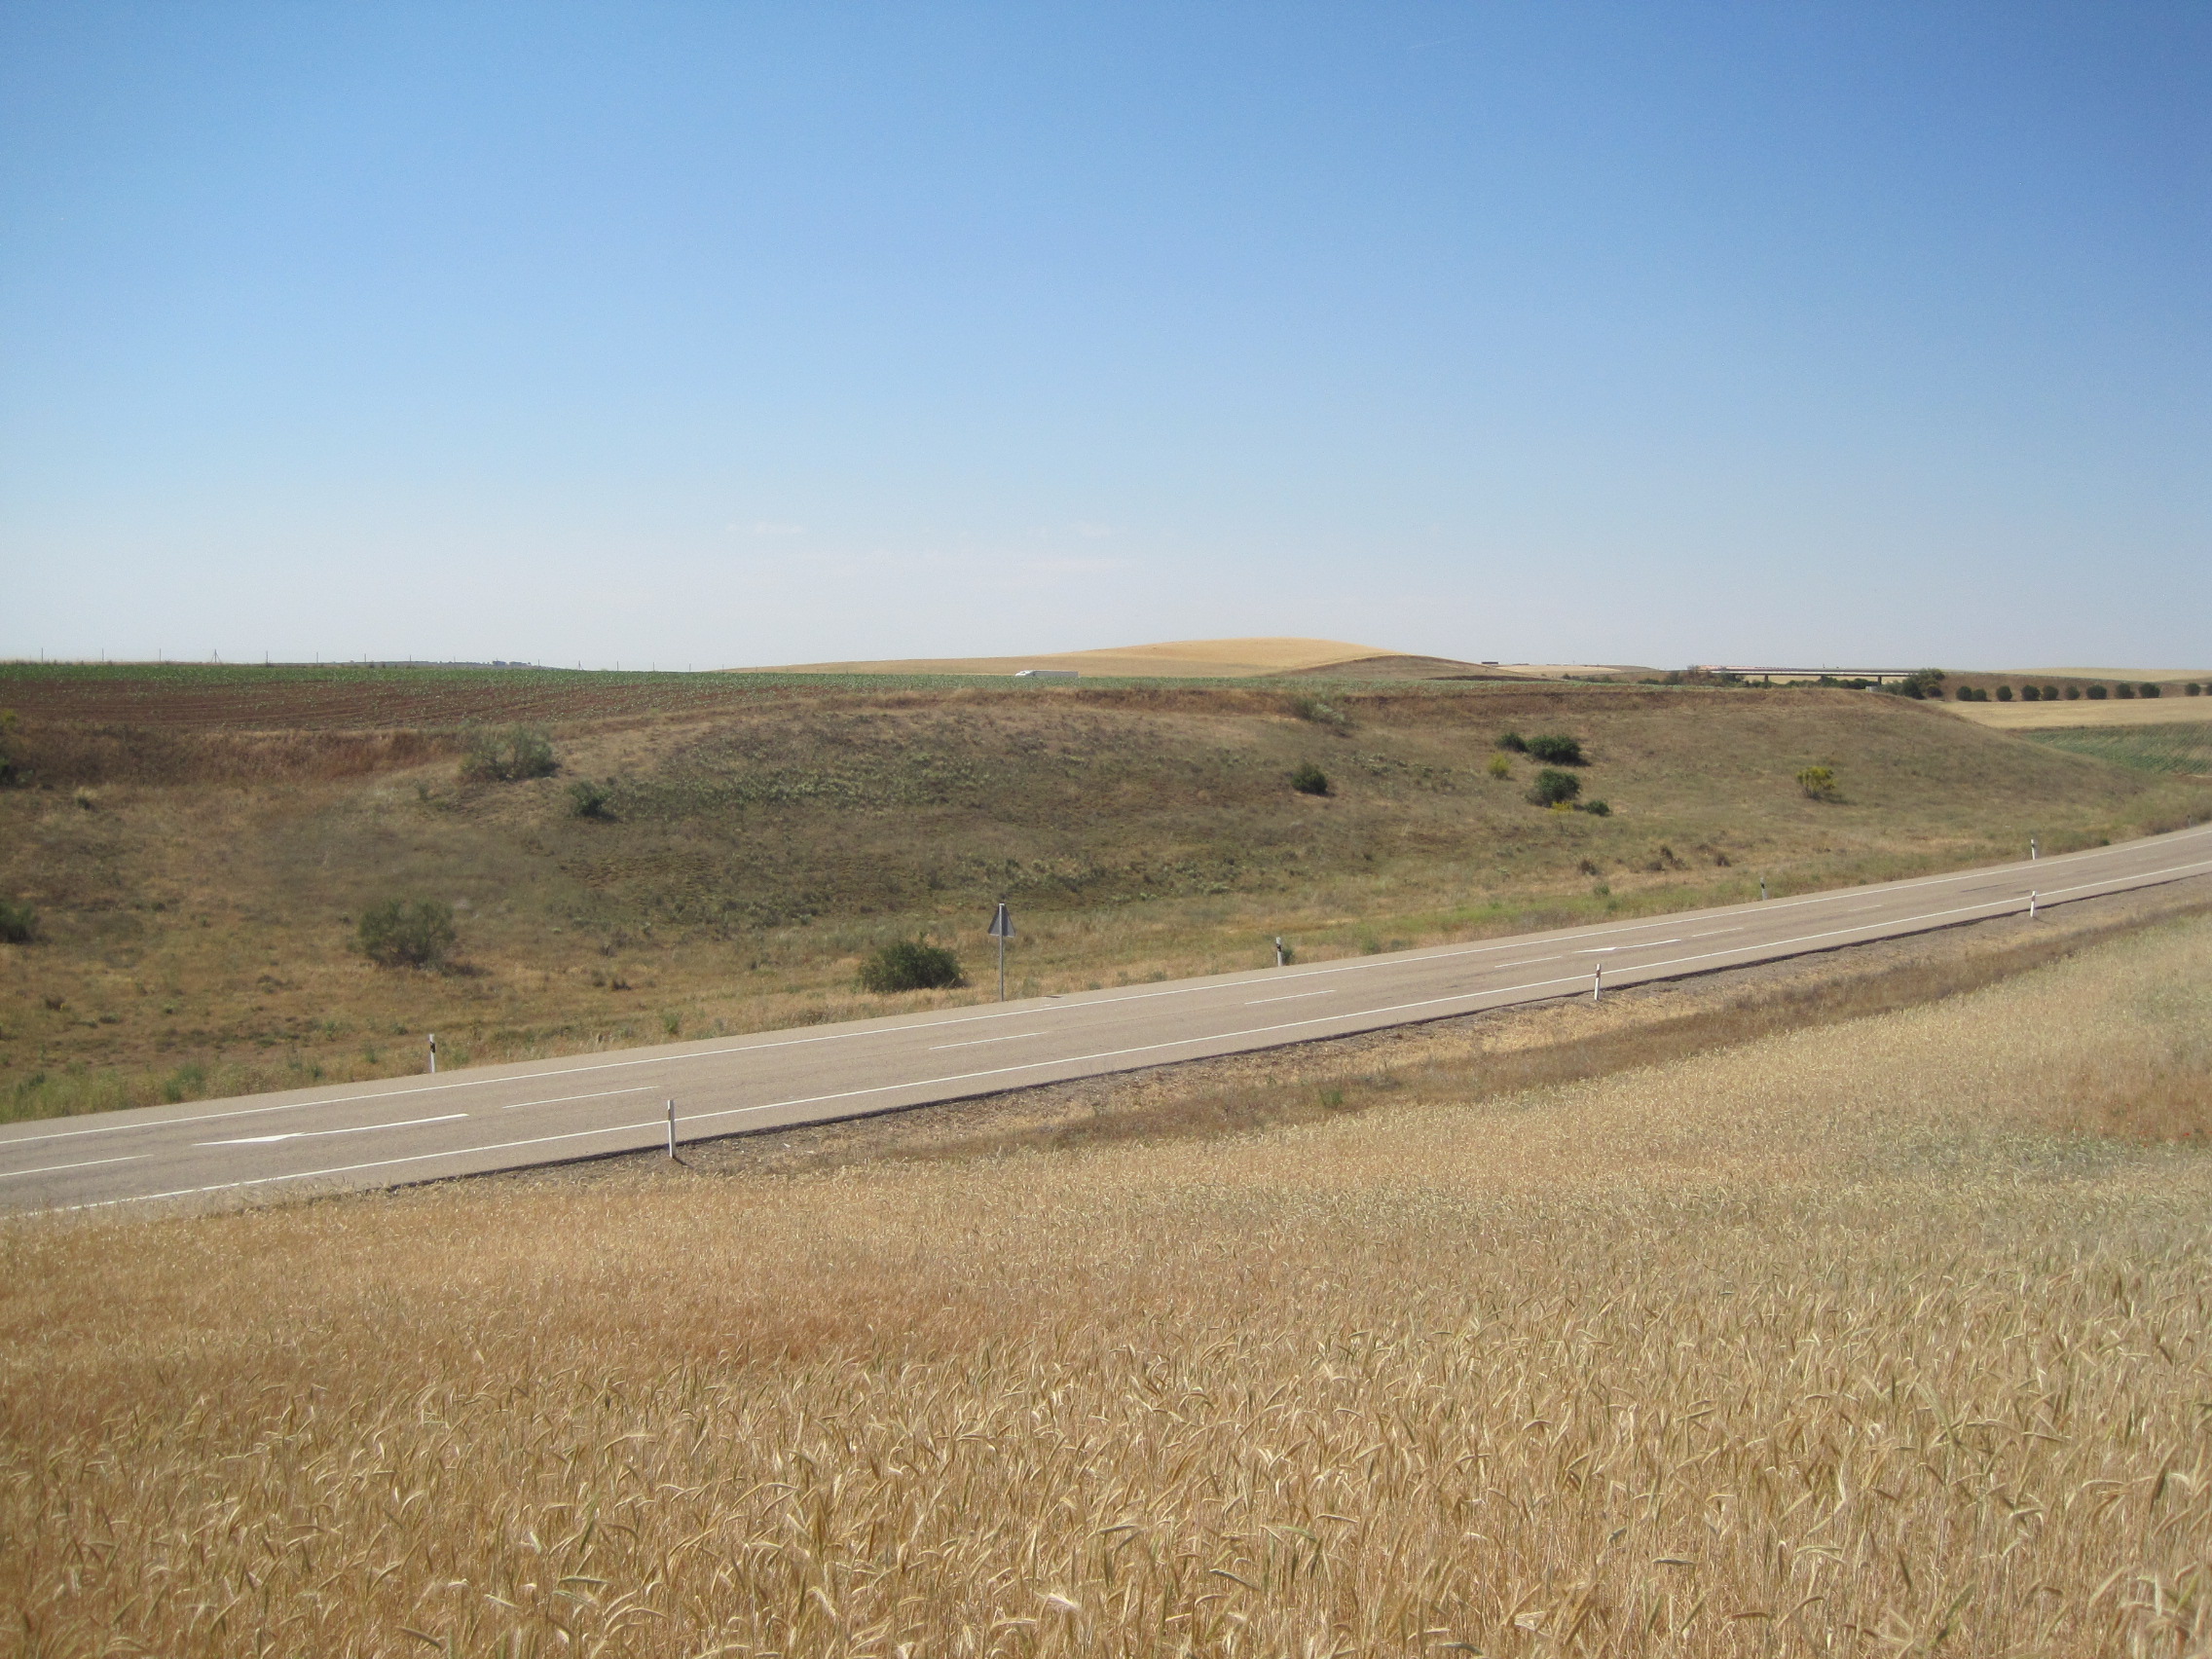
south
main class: Cropland
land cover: Rye
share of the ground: > 75 %
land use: Agriculture (excluding fallow land and kitchen gardens)
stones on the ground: 25 - 50 %
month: June
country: ES
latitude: 41.4420
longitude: -5.0938
